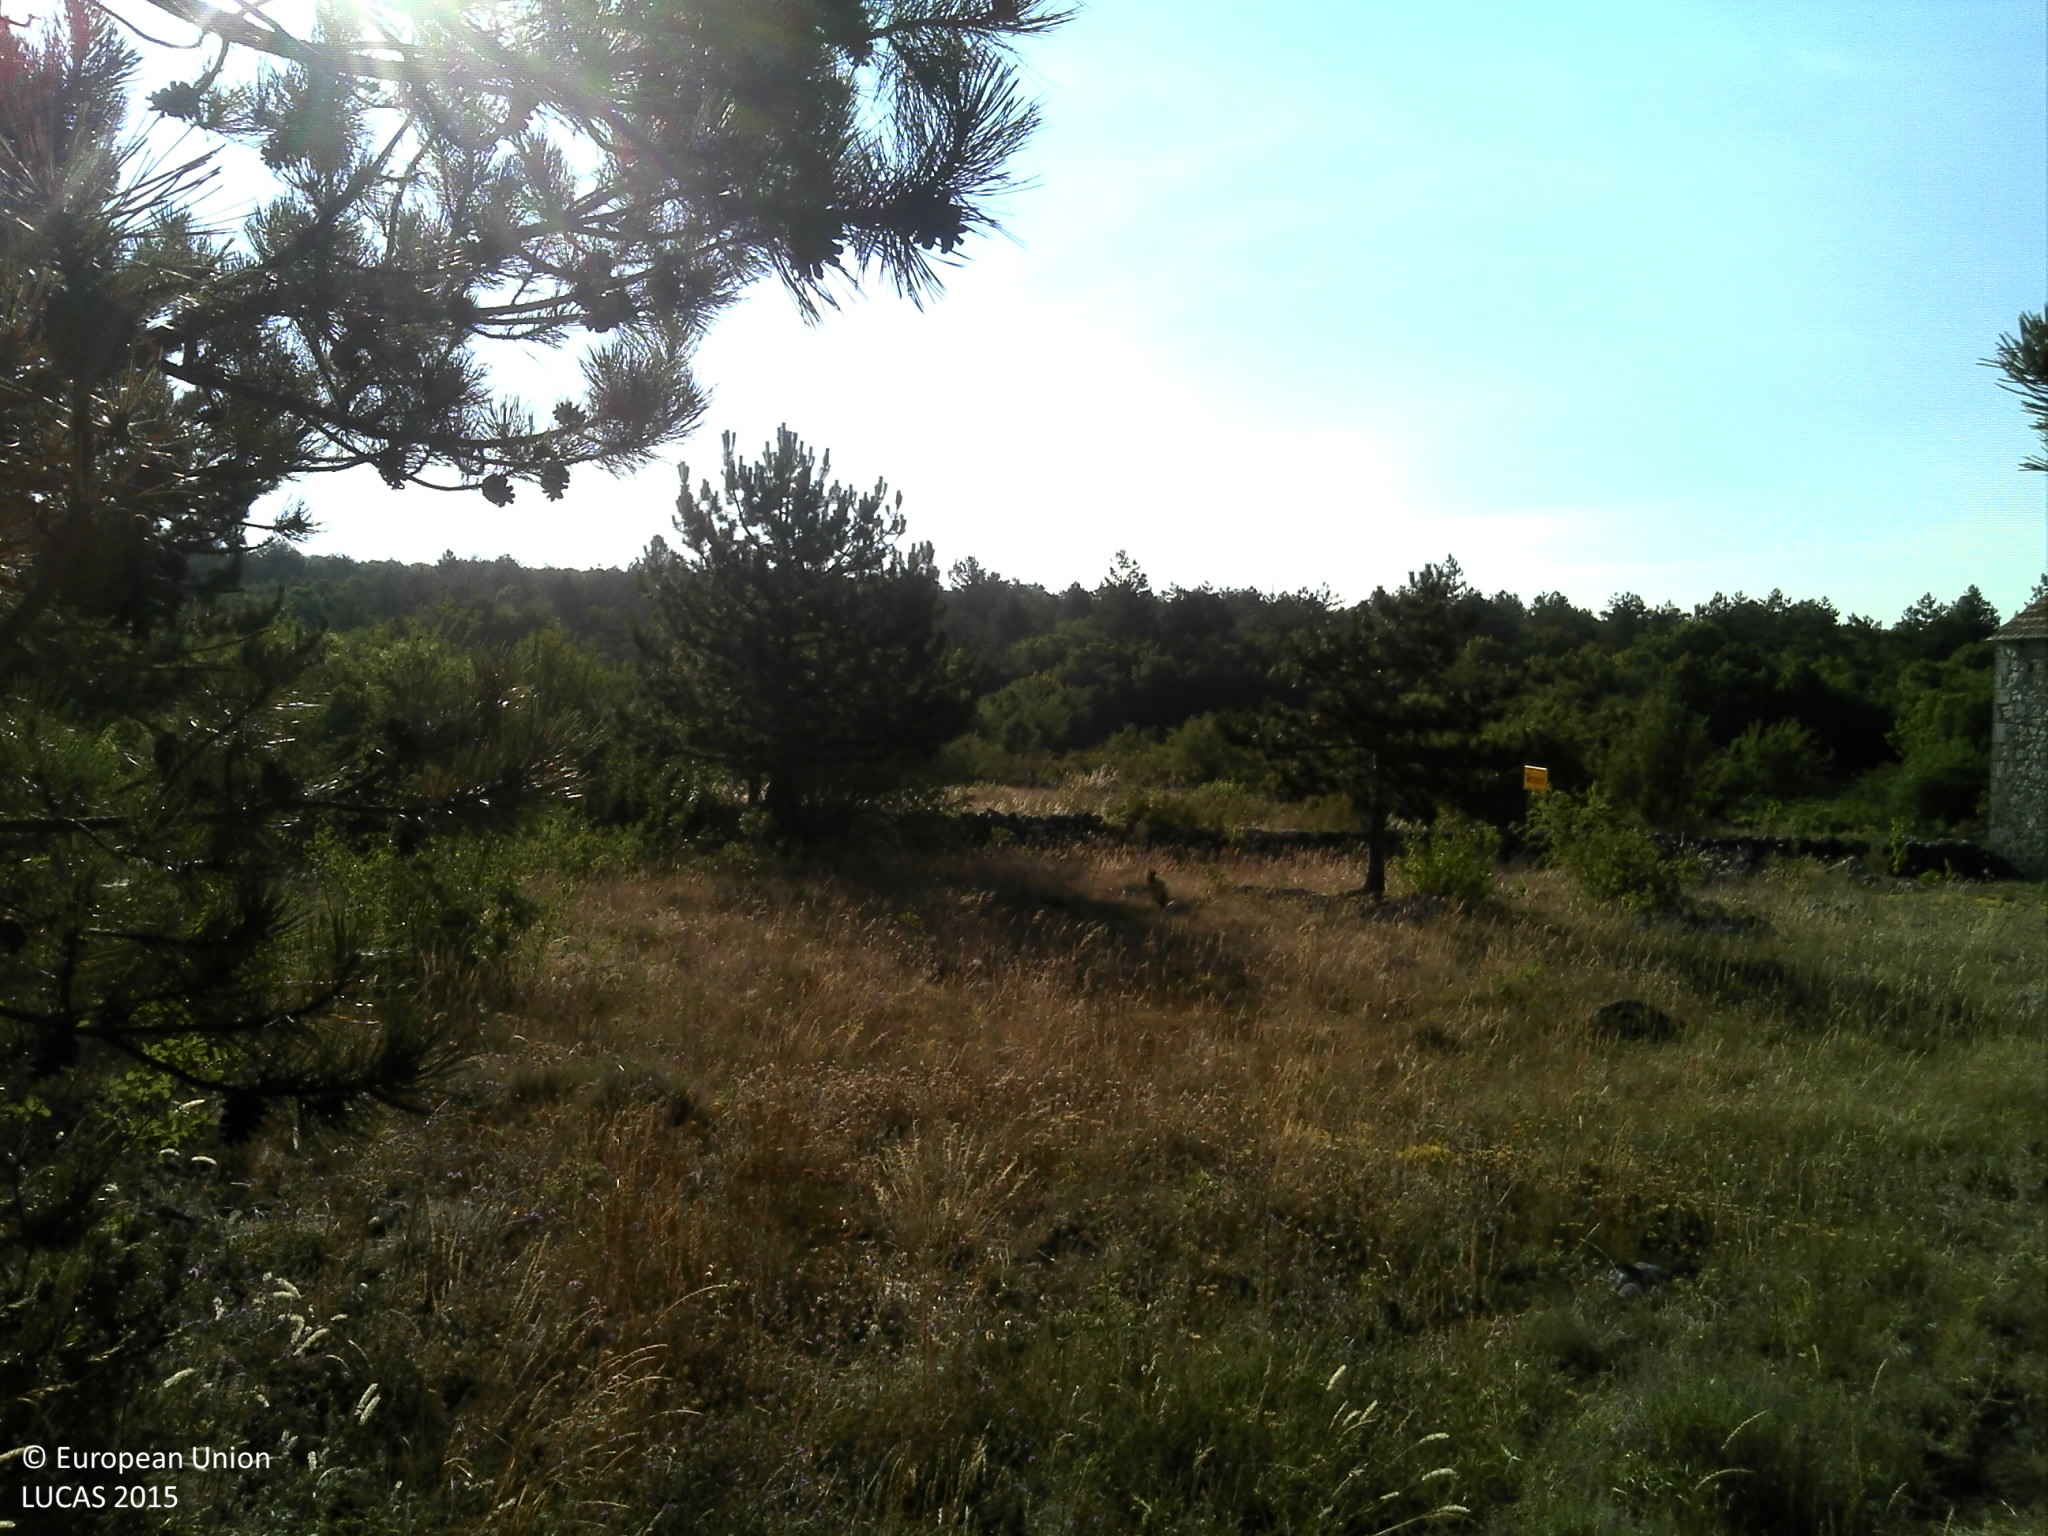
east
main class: Woodland
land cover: Pine dominated coniferous woodland
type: coniferous forest of the mediterranean region
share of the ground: 50 - 75 %
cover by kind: coniferous forest trees 60 %, herbaceous plants 25 %, shrubs 5 %, consolidated bare surface 5 %, unconsolidated bare surface 5 %
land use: Semi-natural and natural areas not in use
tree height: > 5 m
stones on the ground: < 10 %
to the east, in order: Pine dominated coniferous woodland; Dry stone walls; Grass margins; Paved roads, cycling and walking lanes; Grassland with sparse tree/shrub cover; Abandoned hedges; Grassland with sparse tree/shrub cover; Dry stone walls; Grassland with sparse tree/shrub cover; Dry stone walls; Pine dominated coniferous woodland
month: July
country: HR
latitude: 43.4983
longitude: 17.0039
